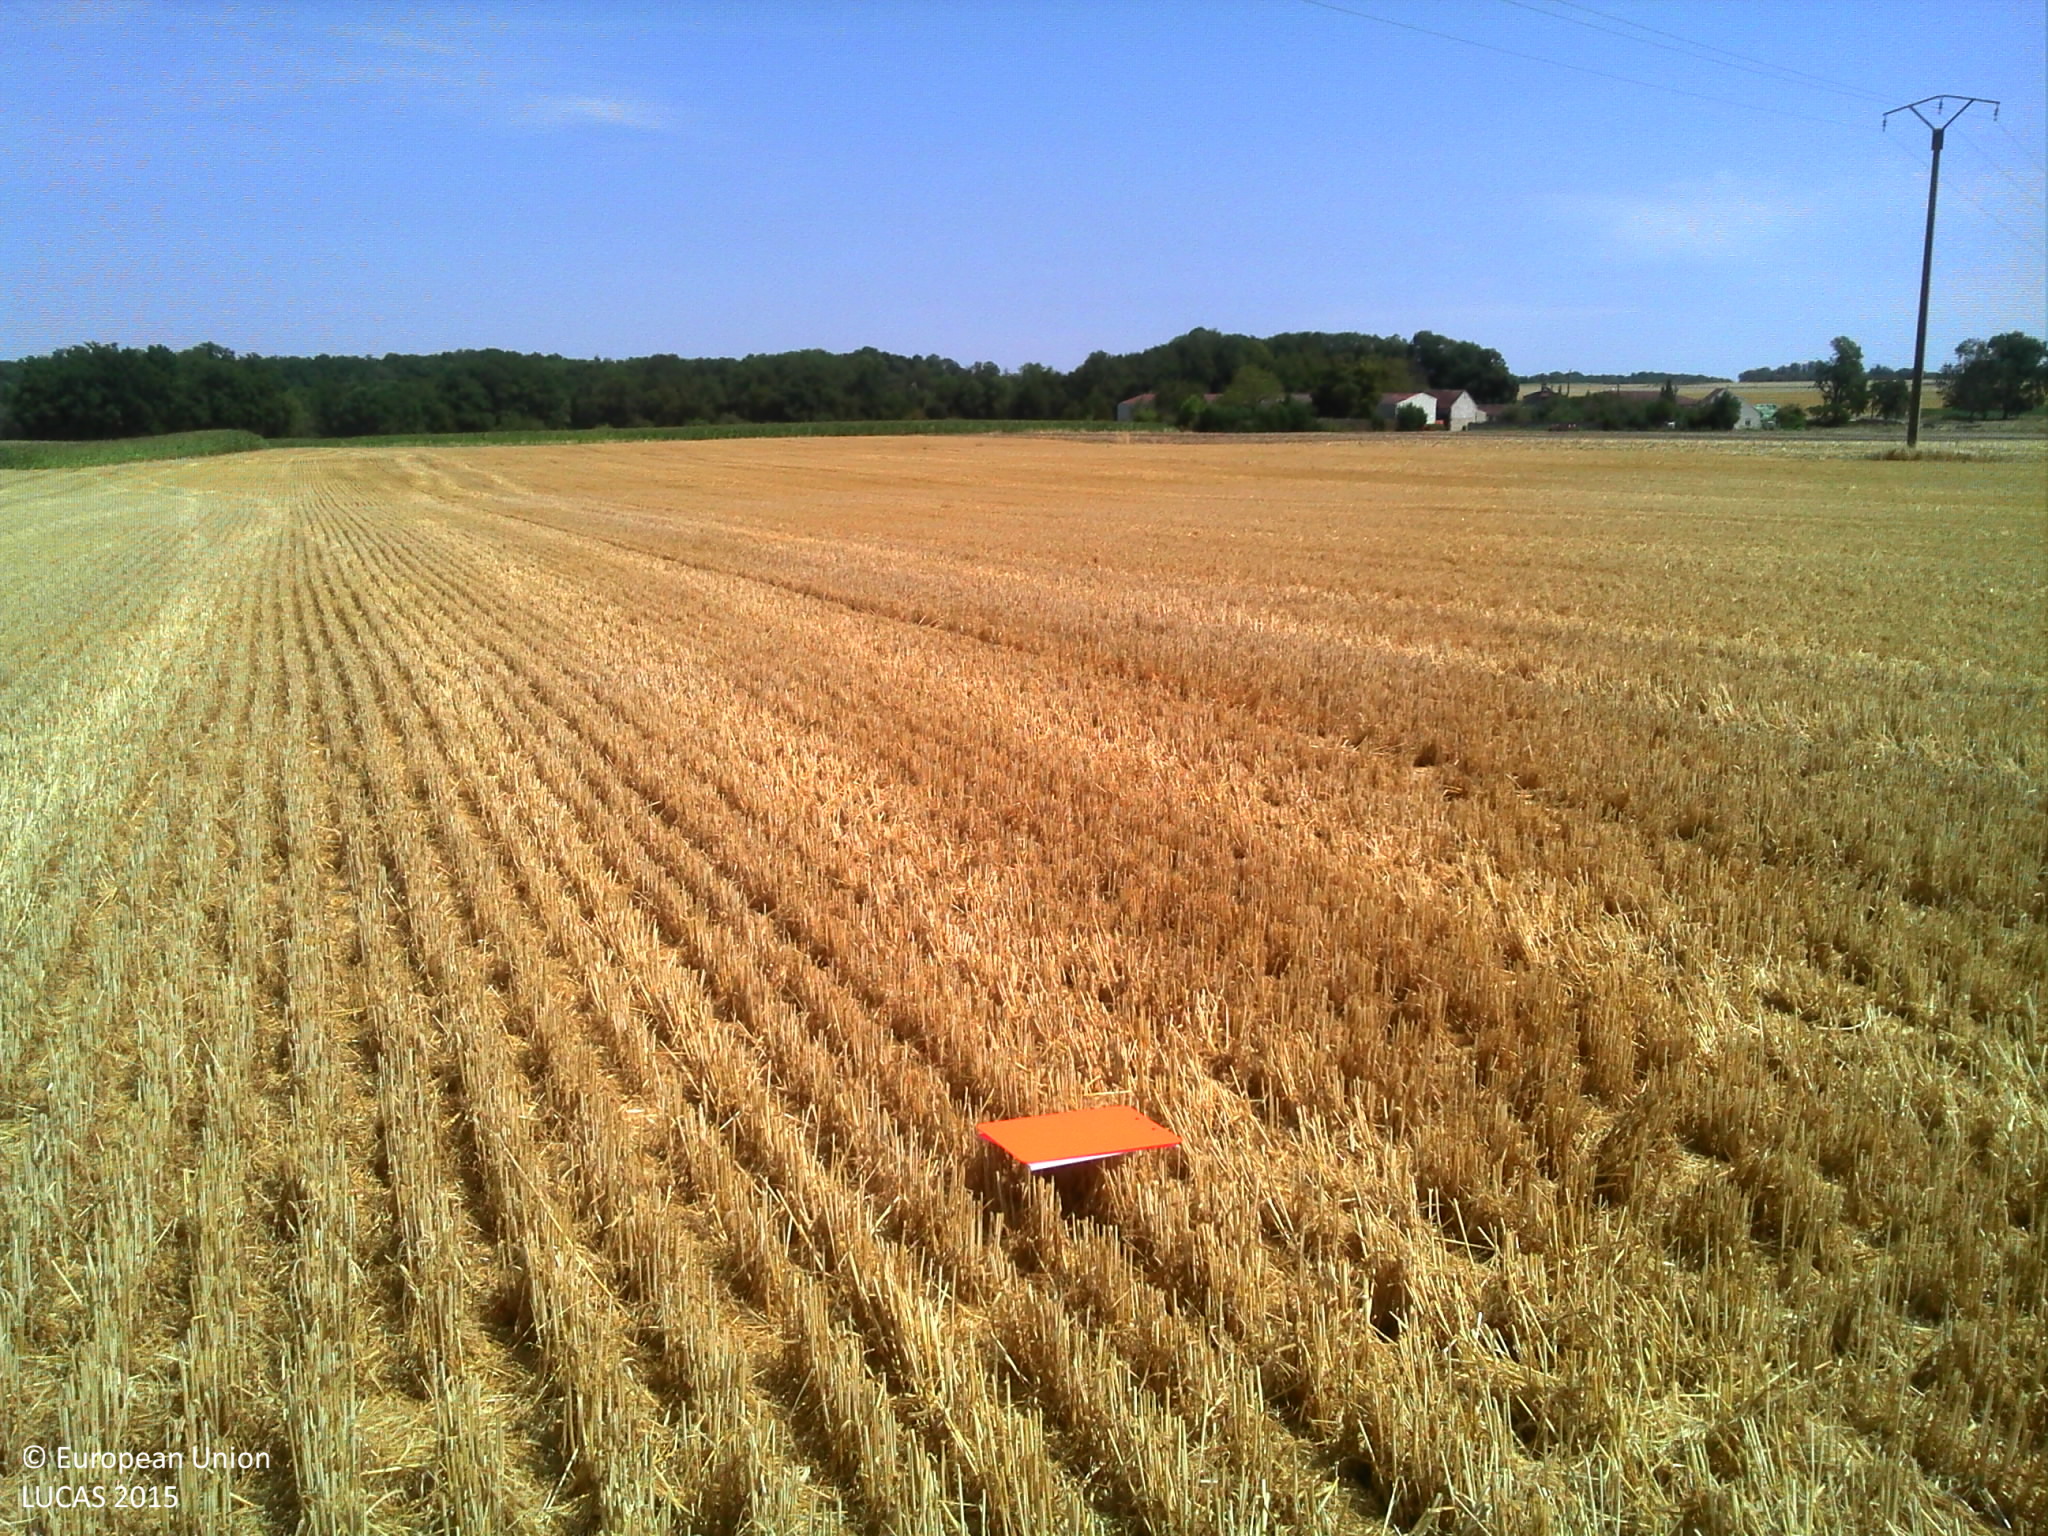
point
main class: Cropland
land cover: Barley
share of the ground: > 75 %
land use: Agriculture (excluding fallow land and kitchen gardens)
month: August
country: FR
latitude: 48.8339
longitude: 3.3309
